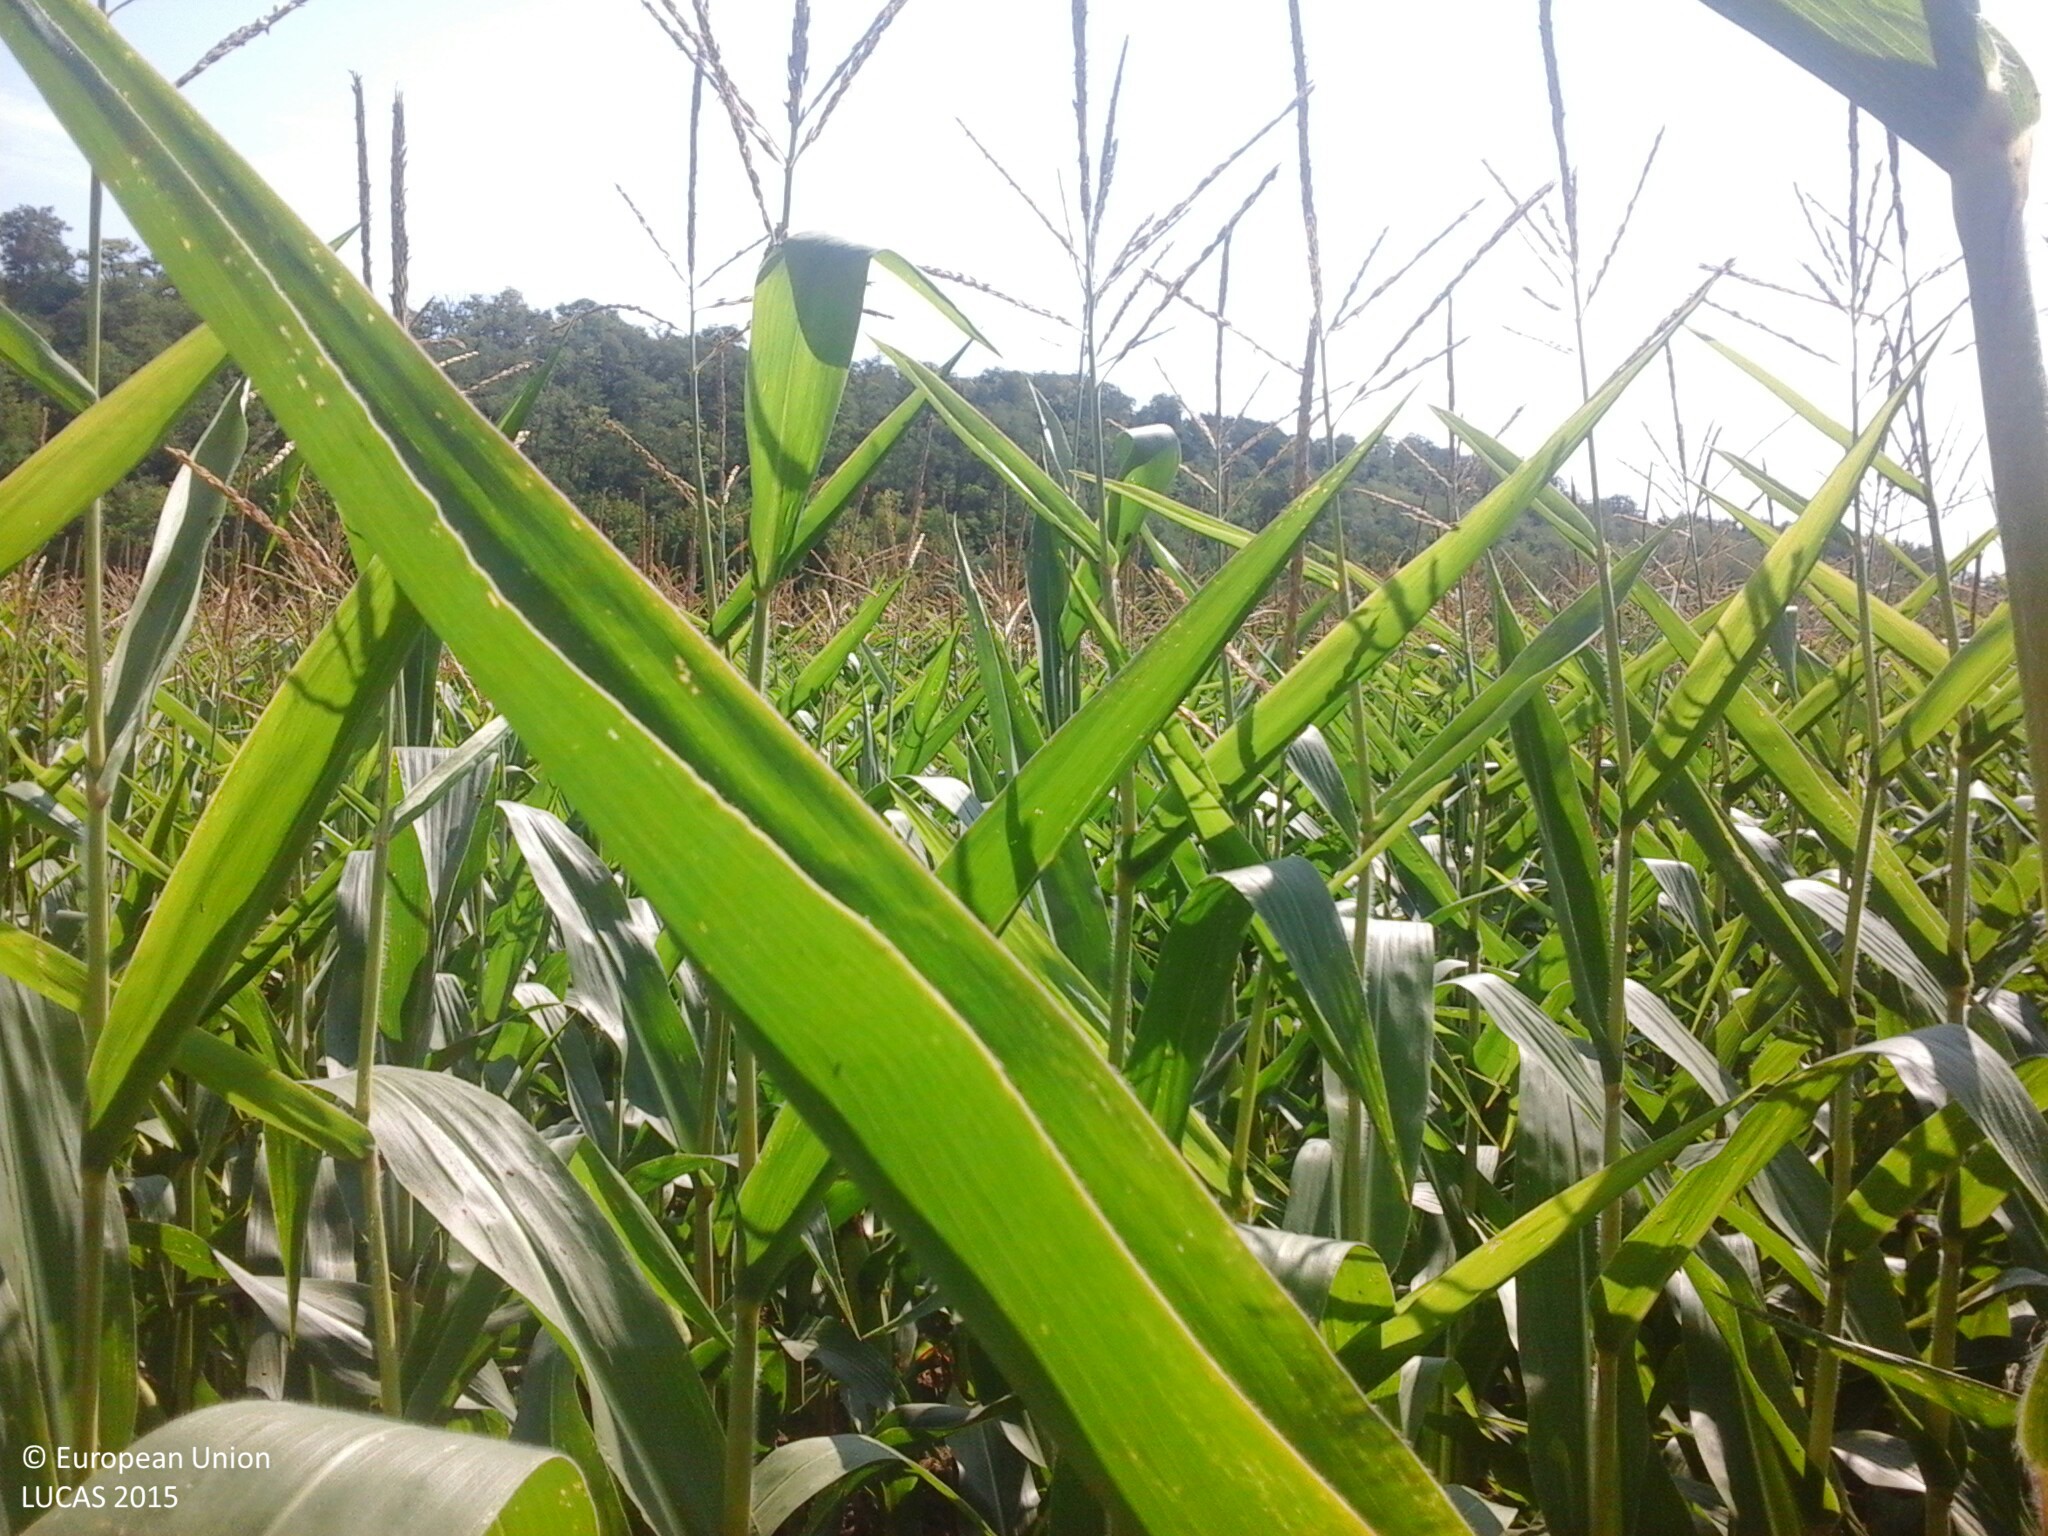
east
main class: Cropland
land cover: Maize
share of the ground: > 75 %
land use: Agriculture (excluding fallow land and kitchen gardens)
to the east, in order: Maize; Grass margins; Ditches and canals; Grass margins; Tracks; Grass margins; Sunflower; Spontaneously vegetated surfaces; Tracks; Broadleaved woodland
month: August
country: HU
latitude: 47.3644
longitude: 18.1013
